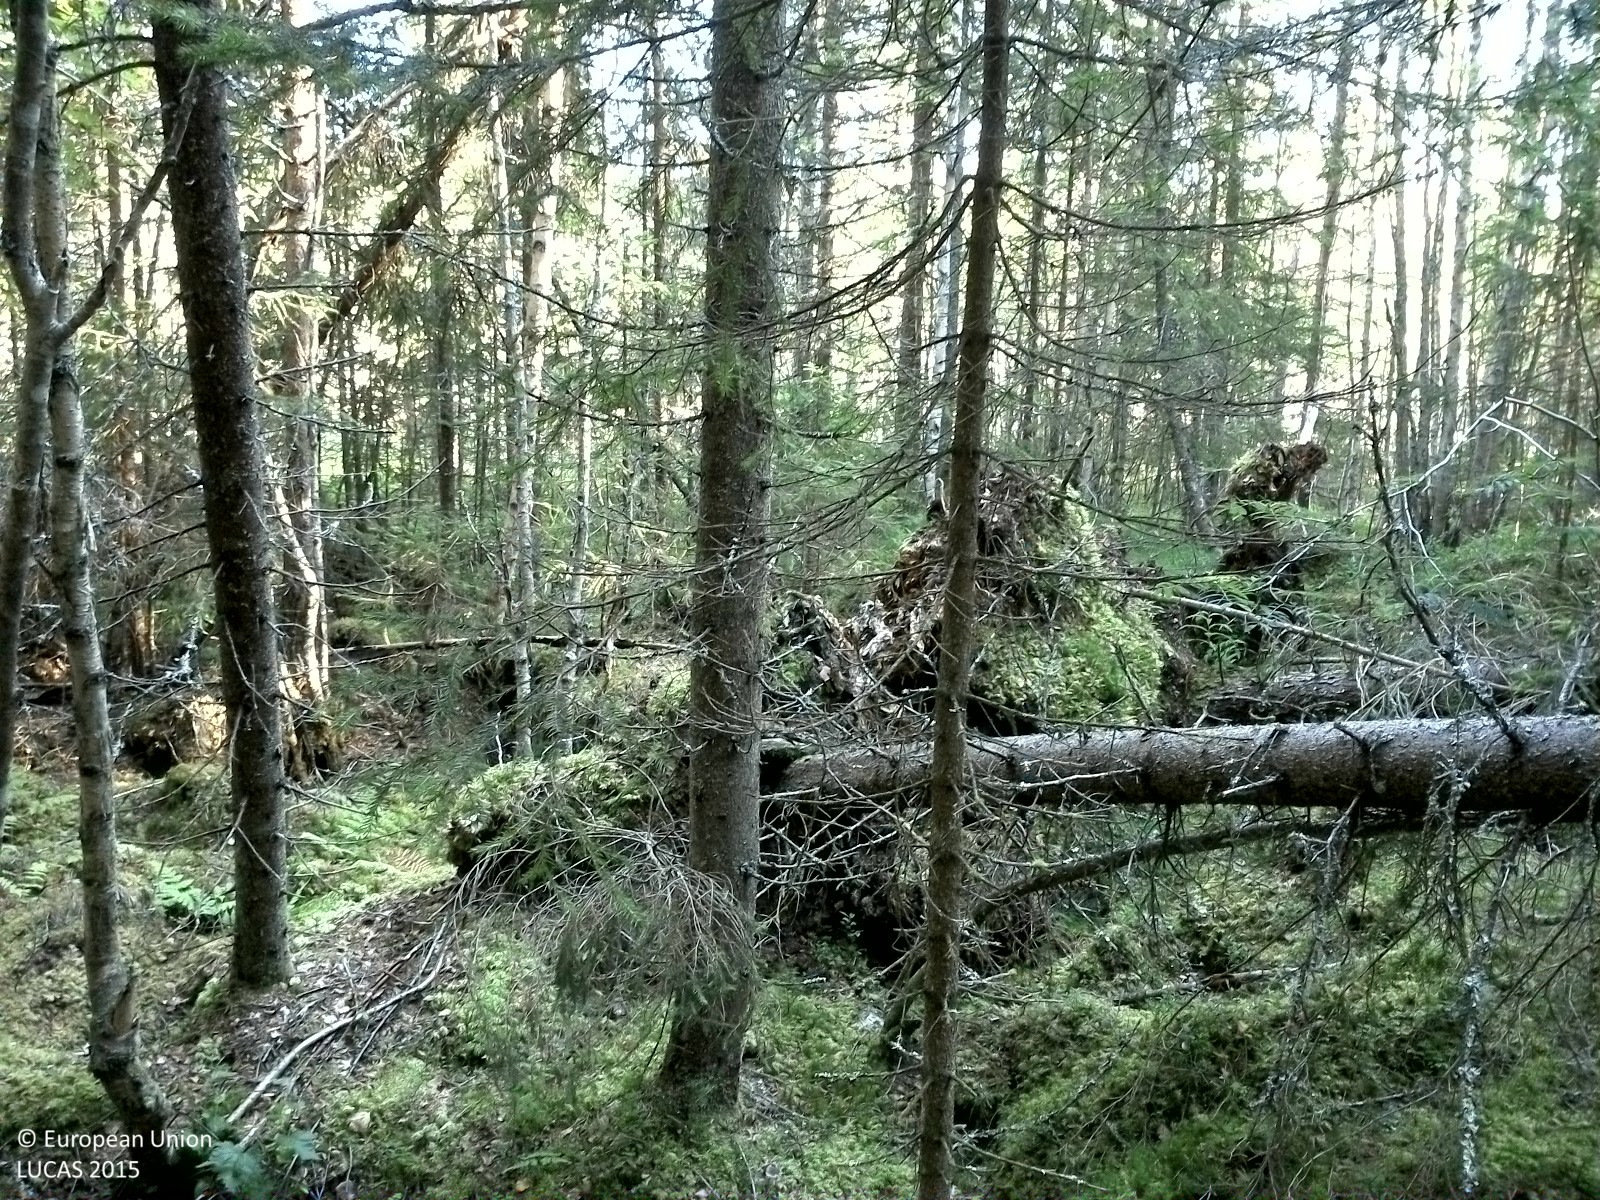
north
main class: Woodland
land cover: Spruce dominated mixed woodland
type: boreal forest
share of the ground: > 75 %
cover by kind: coniferous forest trees 60 %, broadleaved forest trees 20 %, lichens and mosses 20 %
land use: Forestry
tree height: > 5 m
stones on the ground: < 10 %
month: August
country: SE
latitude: 62.3143
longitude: 16.7906
